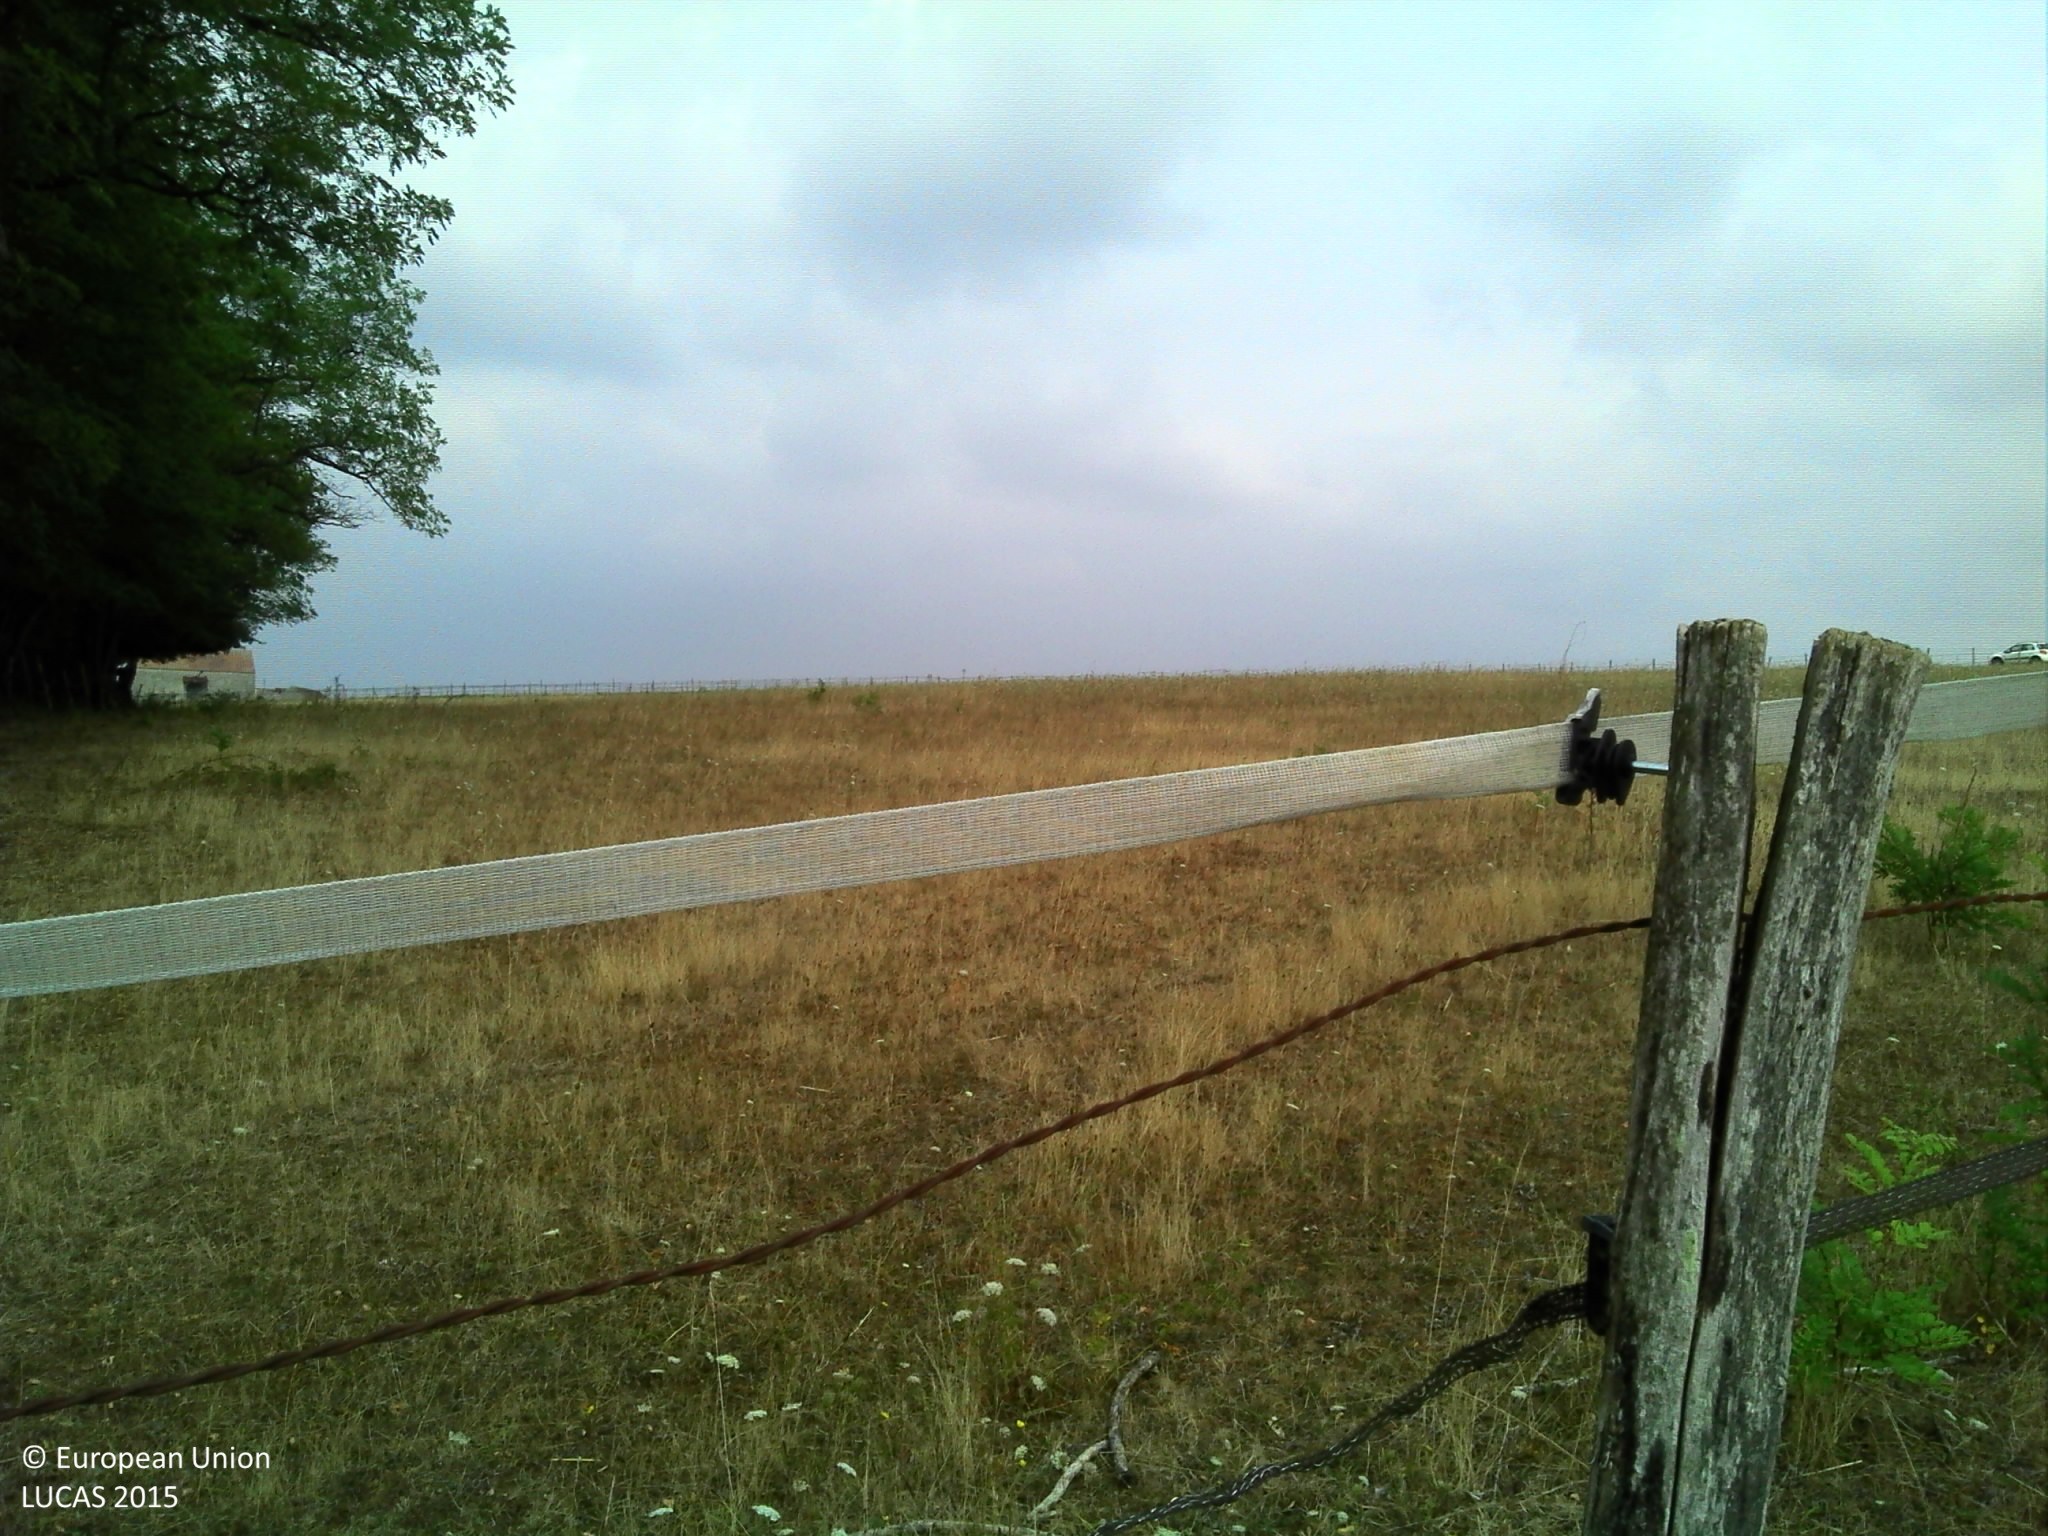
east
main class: Woodland
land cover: Broadleaved woodland
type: mesophytic deciduous forest
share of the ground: > 75 %
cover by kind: broadleaved forest trees 60 %, shrubs 40 %
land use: Forestry
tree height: > 5 m
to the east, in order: Broadleaved woodland; Fences; Grassland without tree/shrub cover; Fences; Grass margins; Tracks; Grass margins; Fences; Grassland without tree/shrub cover; Fences; Tracks; Fences; Grassland without tree/shrub cover
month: August
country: FR
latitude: 48.2187
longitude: 2.7365
